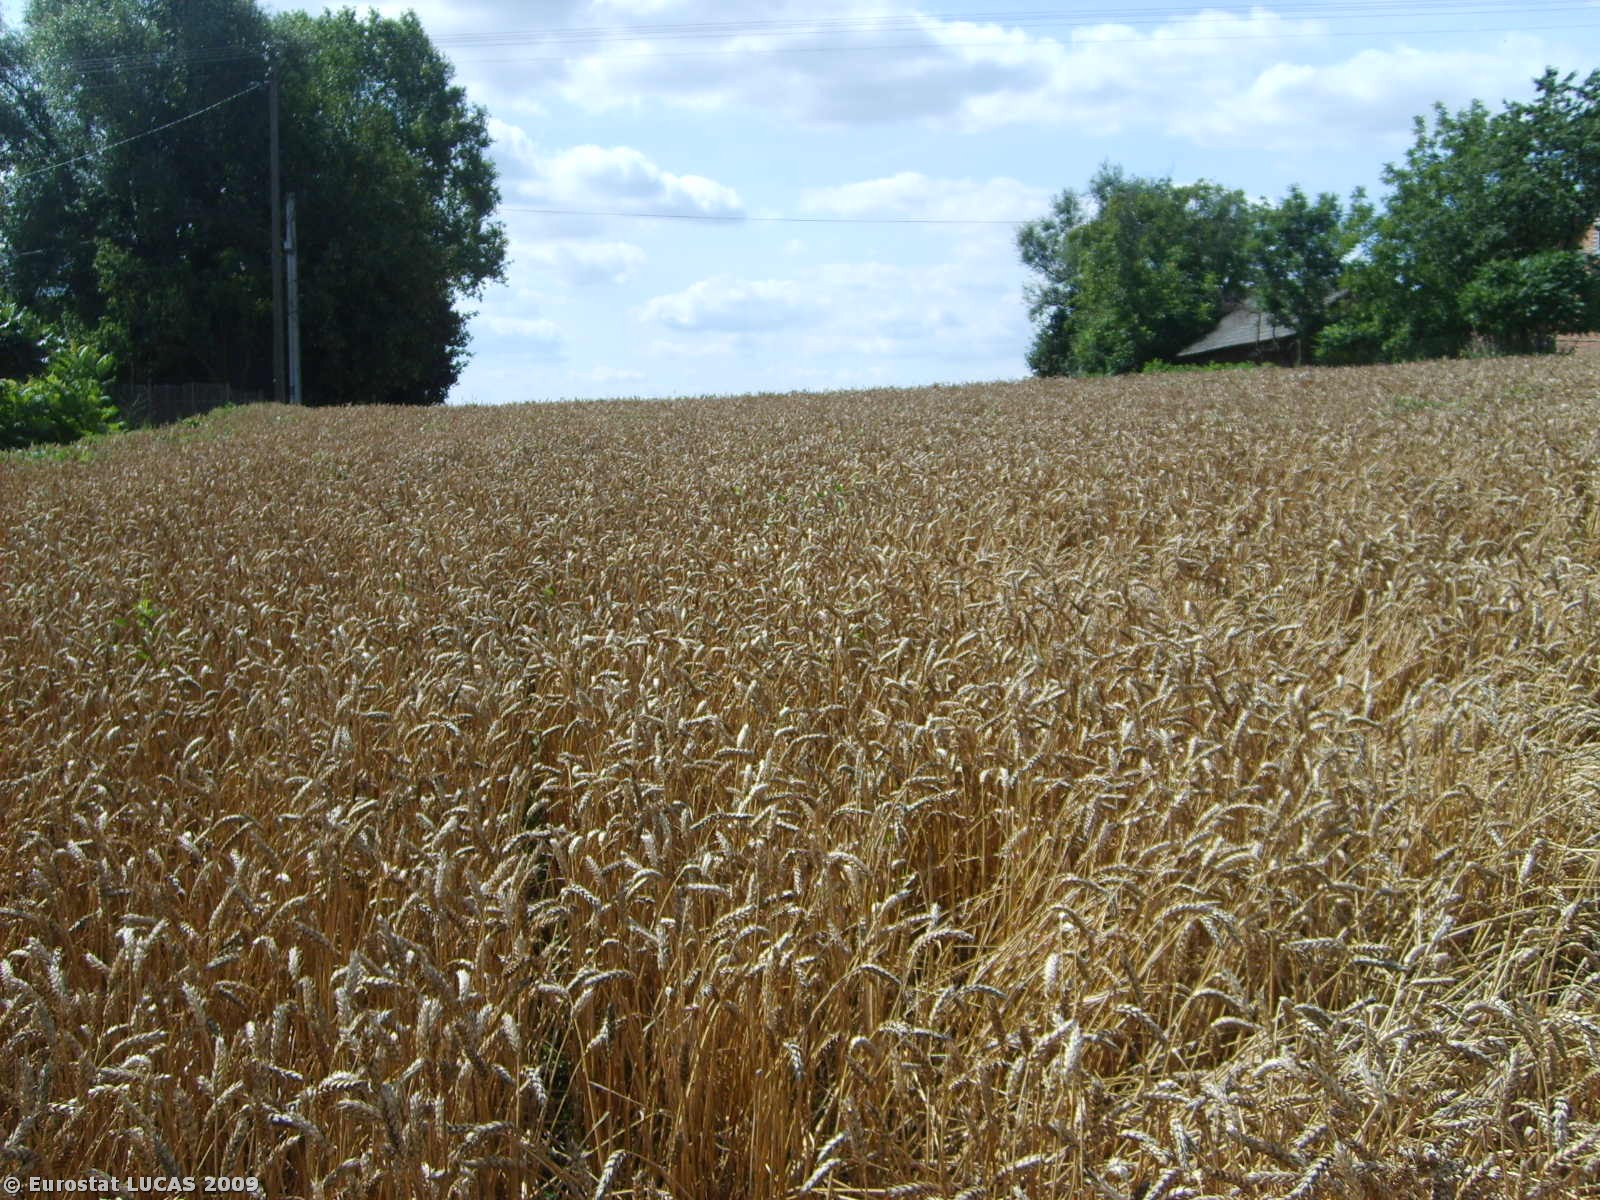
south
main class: Cropland
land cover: Common wheat
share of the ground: > 75 %
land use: Agriculture (excluding fallow land and kitchen gardens)
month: July
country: PL
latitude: 50.3172
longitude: 20.2734
